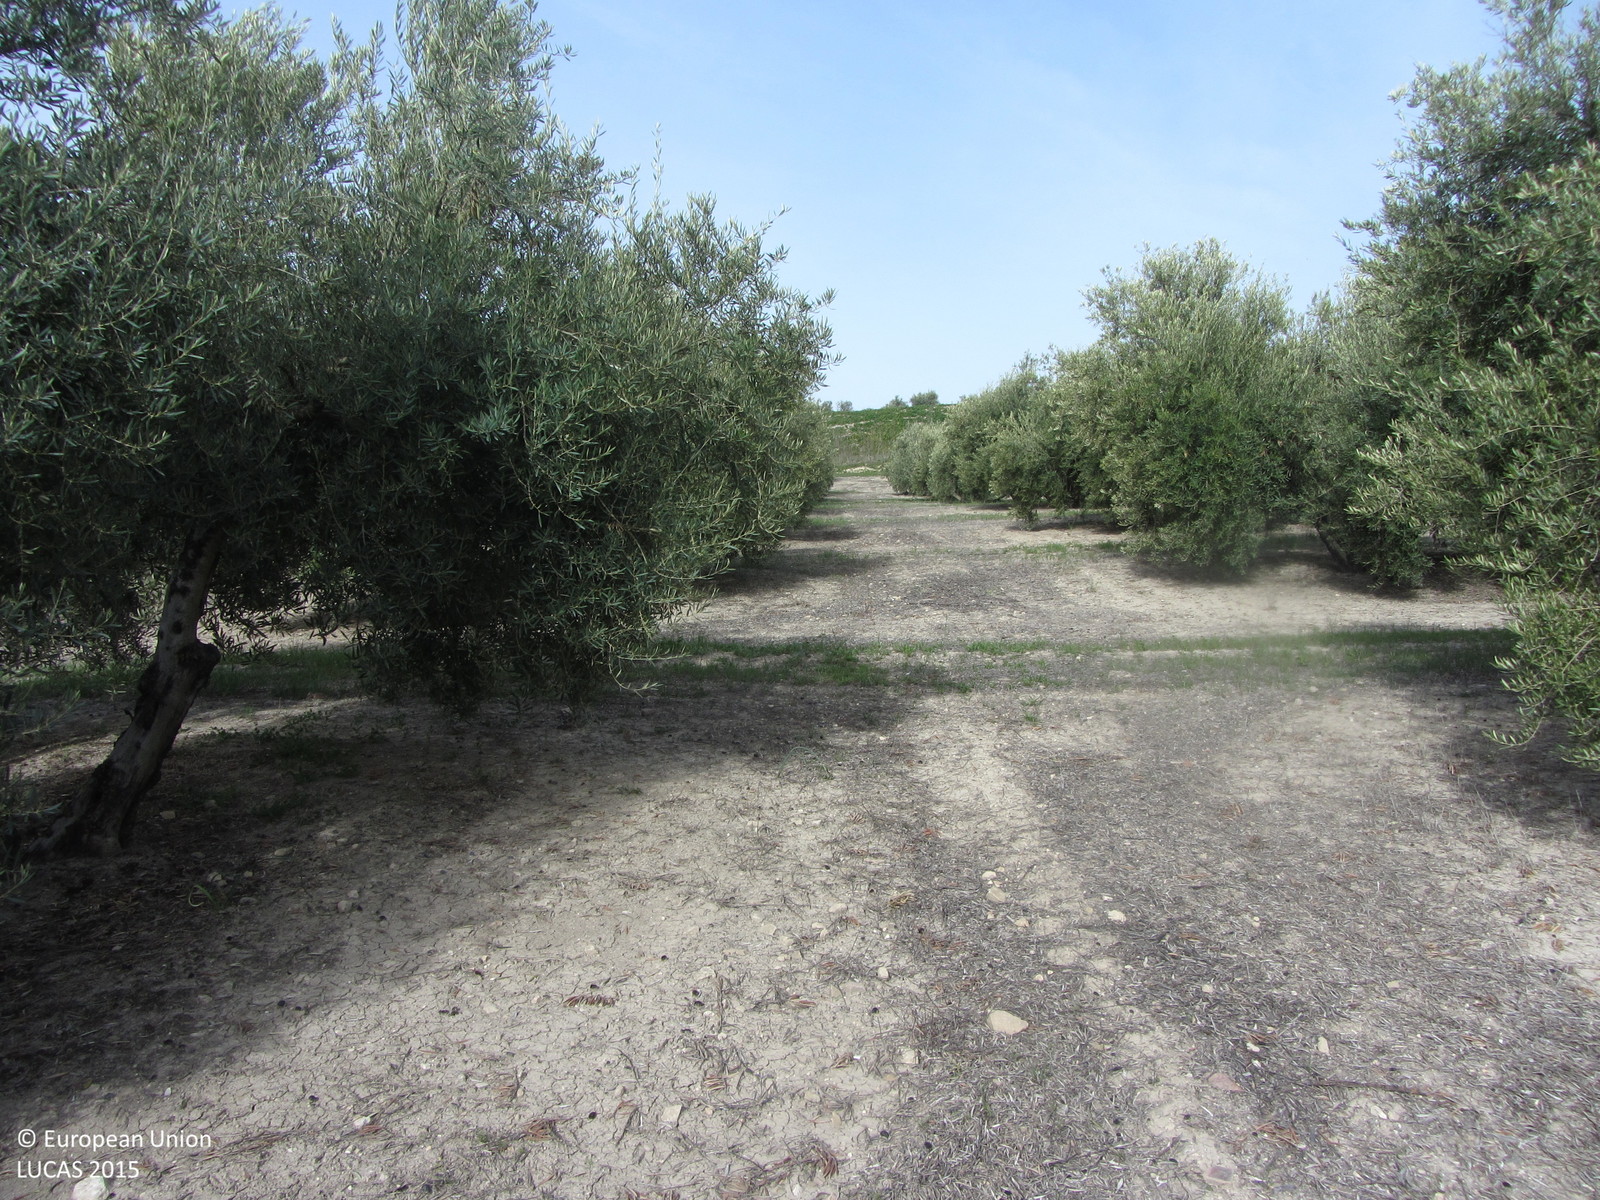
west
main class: Cropland
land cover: Olive groves
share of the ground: 50 - 75 %
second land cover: Spontaneously vegetated surfaces
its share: 10 - 25 %
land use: Agriculture (excluding fallow land and kitchen gardens)
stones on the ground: < 10 %
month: April
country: ES
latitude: 38.1054
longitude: -3.0794
